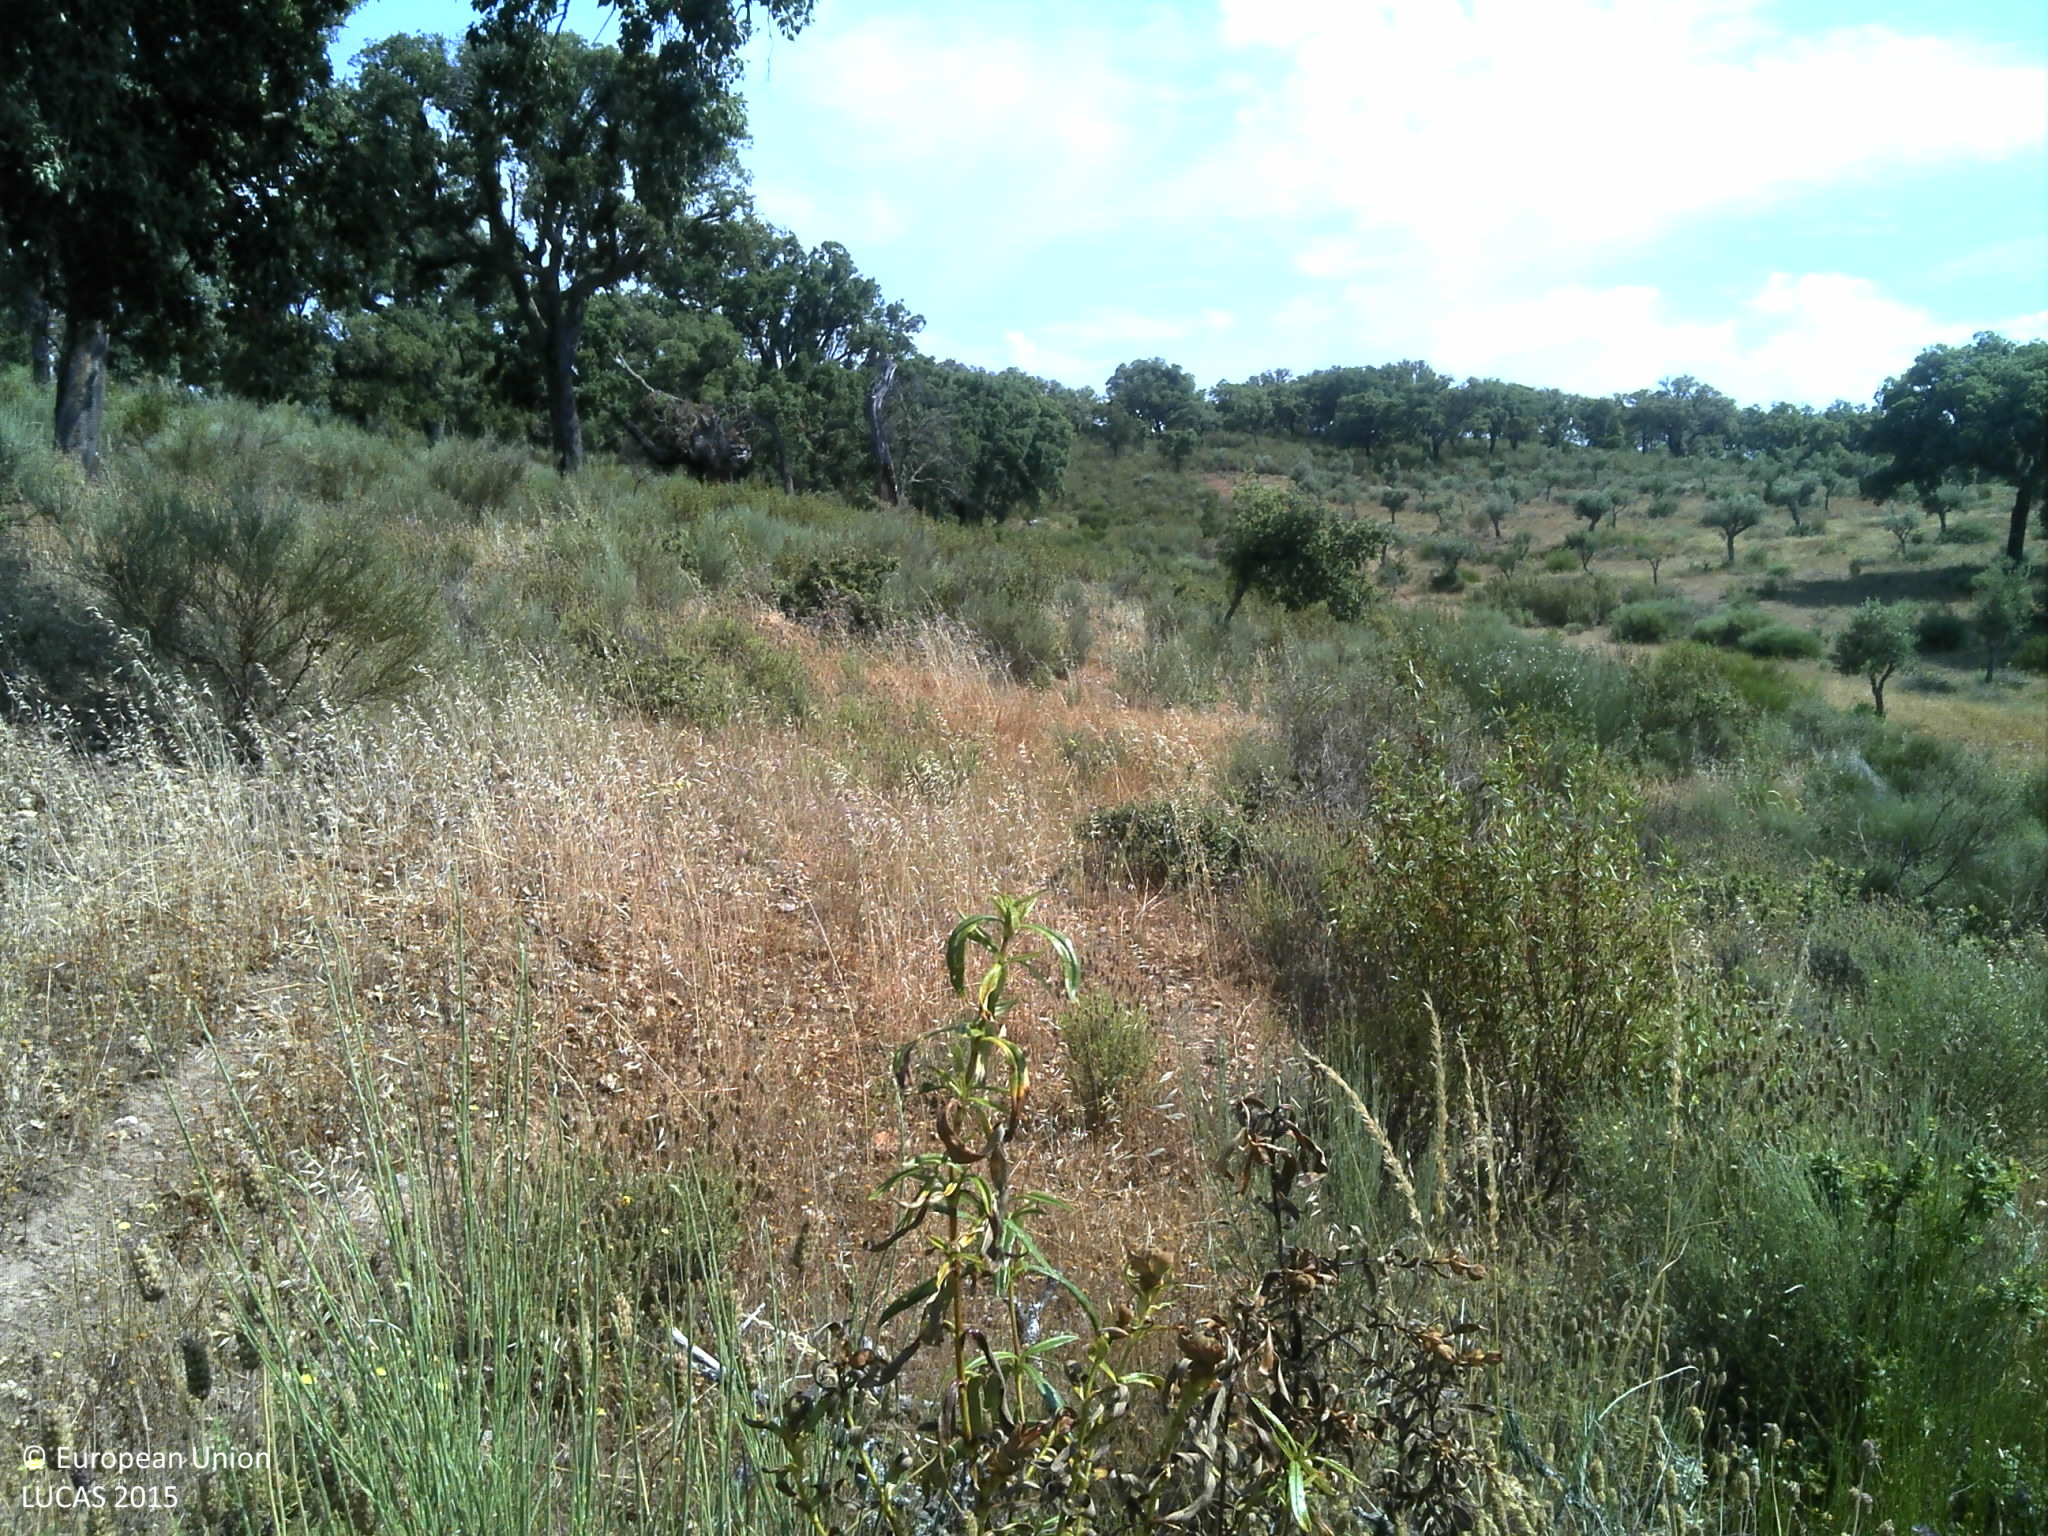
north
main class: Woodland
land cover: Broadleaved woodland
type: broadleaved evergreen forest
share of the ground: 10 - 25 %
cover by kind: shrubs 40 %, herbaceous plants 25 %, broadleaved forest trees 15 %, consolidated bare surface 10 %, unconsolidated bare surface 10 %
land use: Forestry
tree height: > 5 m
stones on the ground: 10 - 25 %
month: June
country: PT
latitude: 41.5489
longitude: -7.0318
